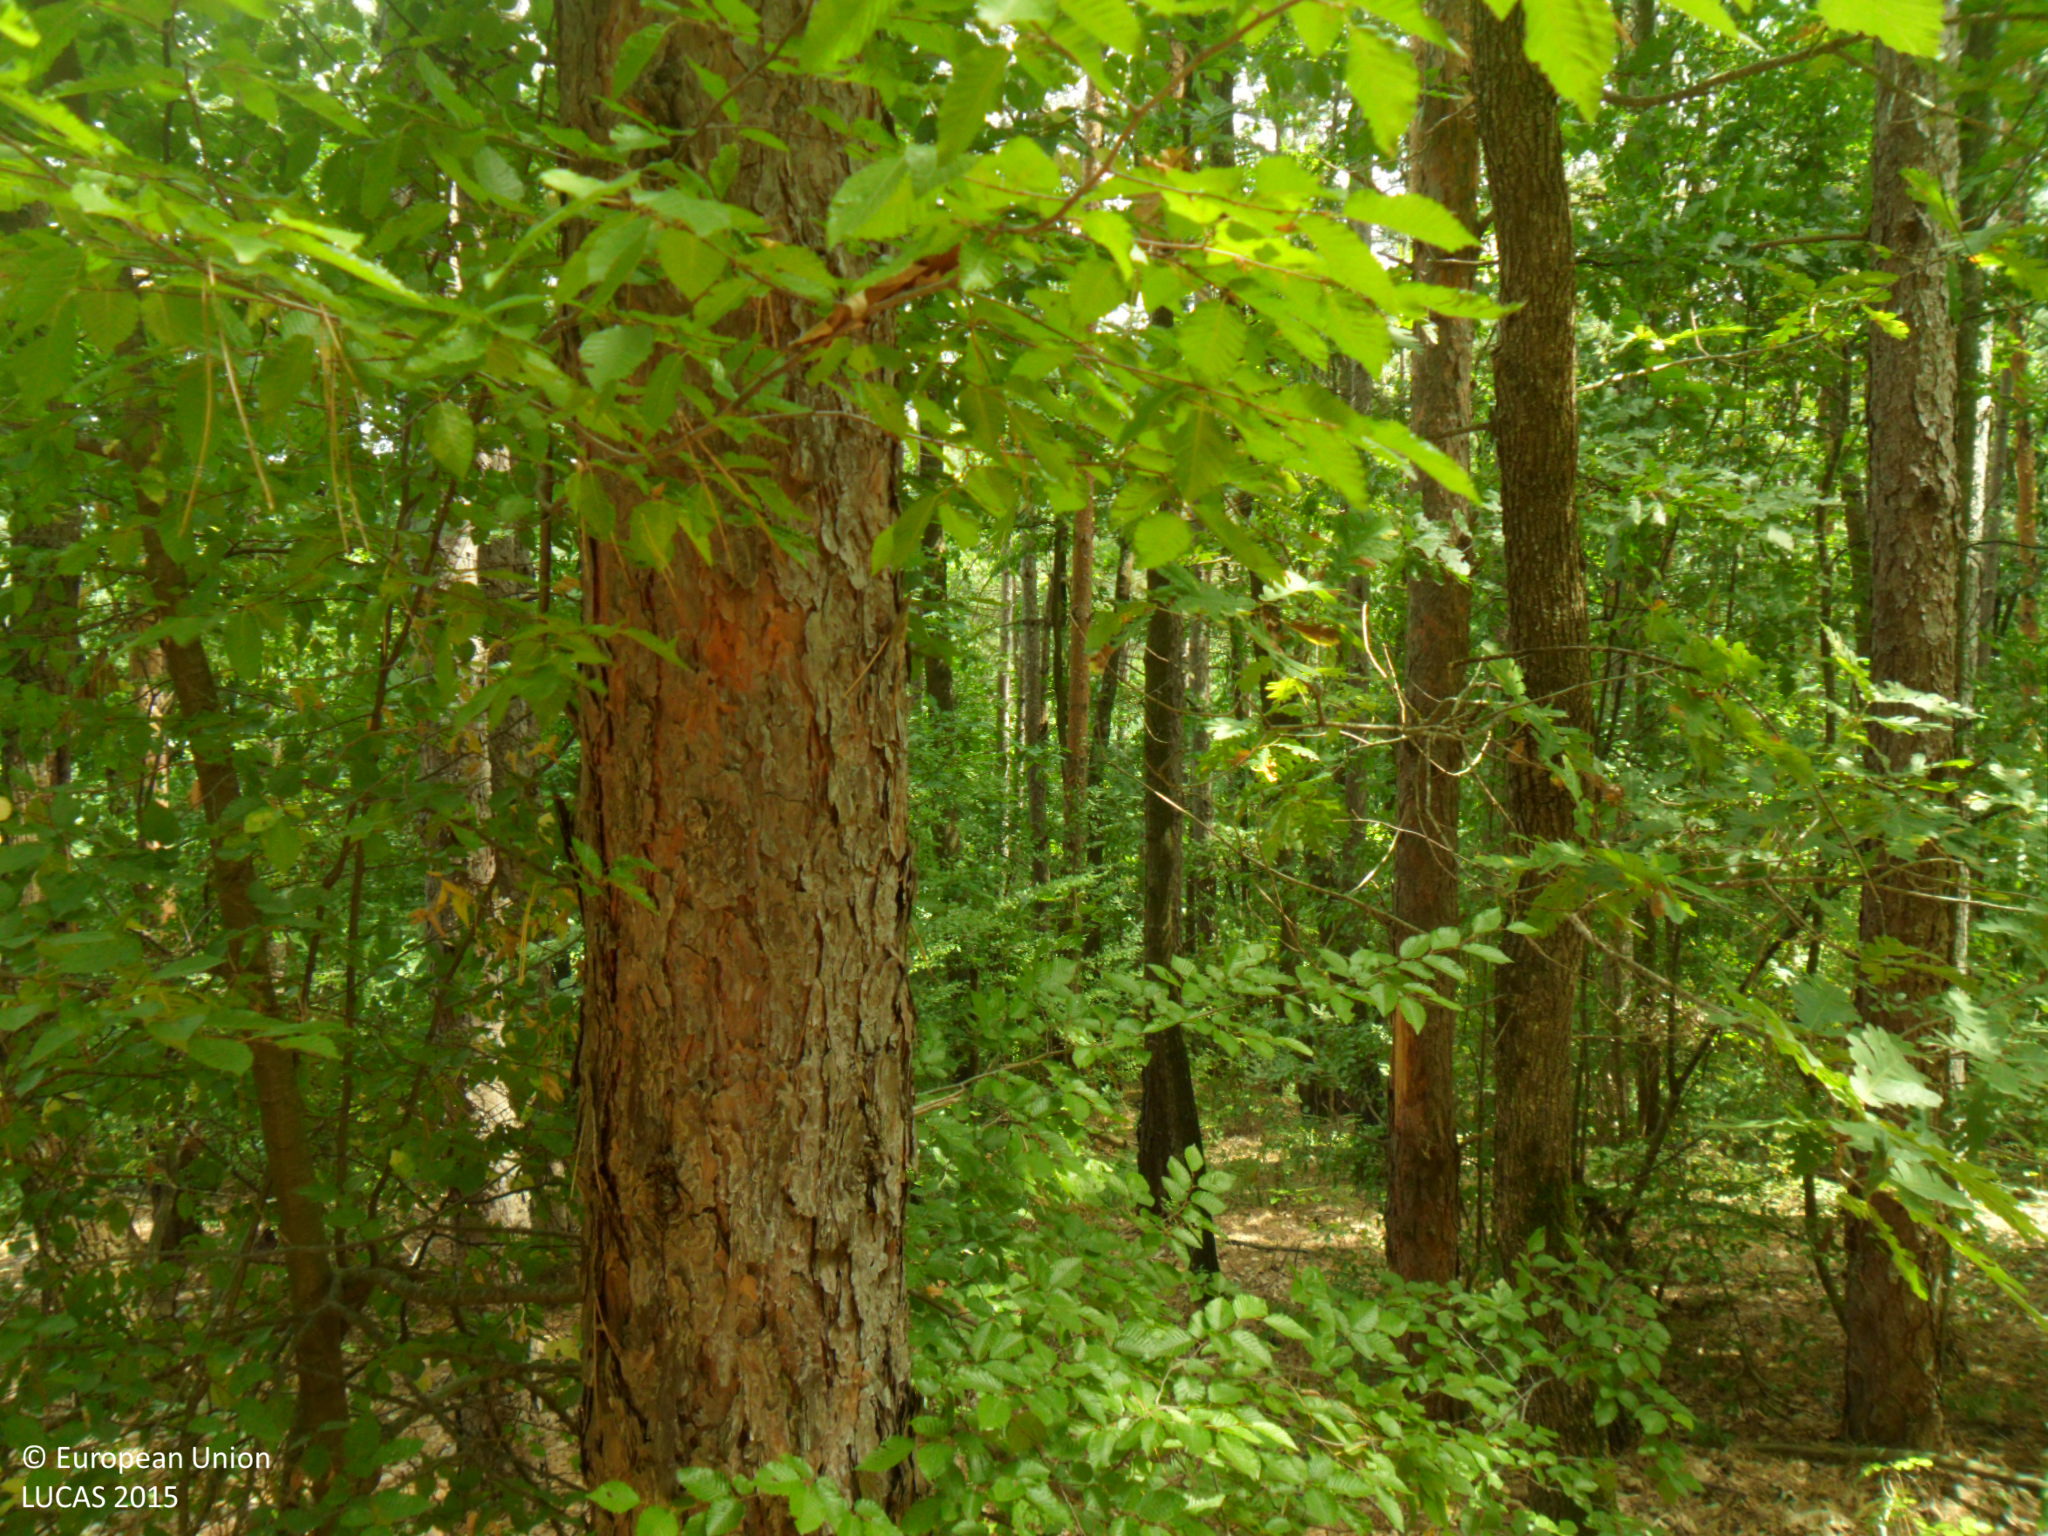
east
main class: Woodland
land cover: Pine dominated mixed woodland
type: hemiboreal forest and nemoral coniferous forest and mixed broadleaved-coniferous forest
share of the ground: > 75 %
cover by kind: coniferous forest trees 50 %, broadleaved forest trees 50 %
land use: Forestry
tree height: > 5 m
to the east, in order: Pine dominated mixed woodland; Dry stone walls; Paved roads, cycling and walking lanes; Broadleaved woodland; Rivers and streams; Broadleaved woodland; Pine dominated coniferous woodland; Broadleaved woodland
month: August
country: BG
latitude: 42.9742
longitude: 26.7684
